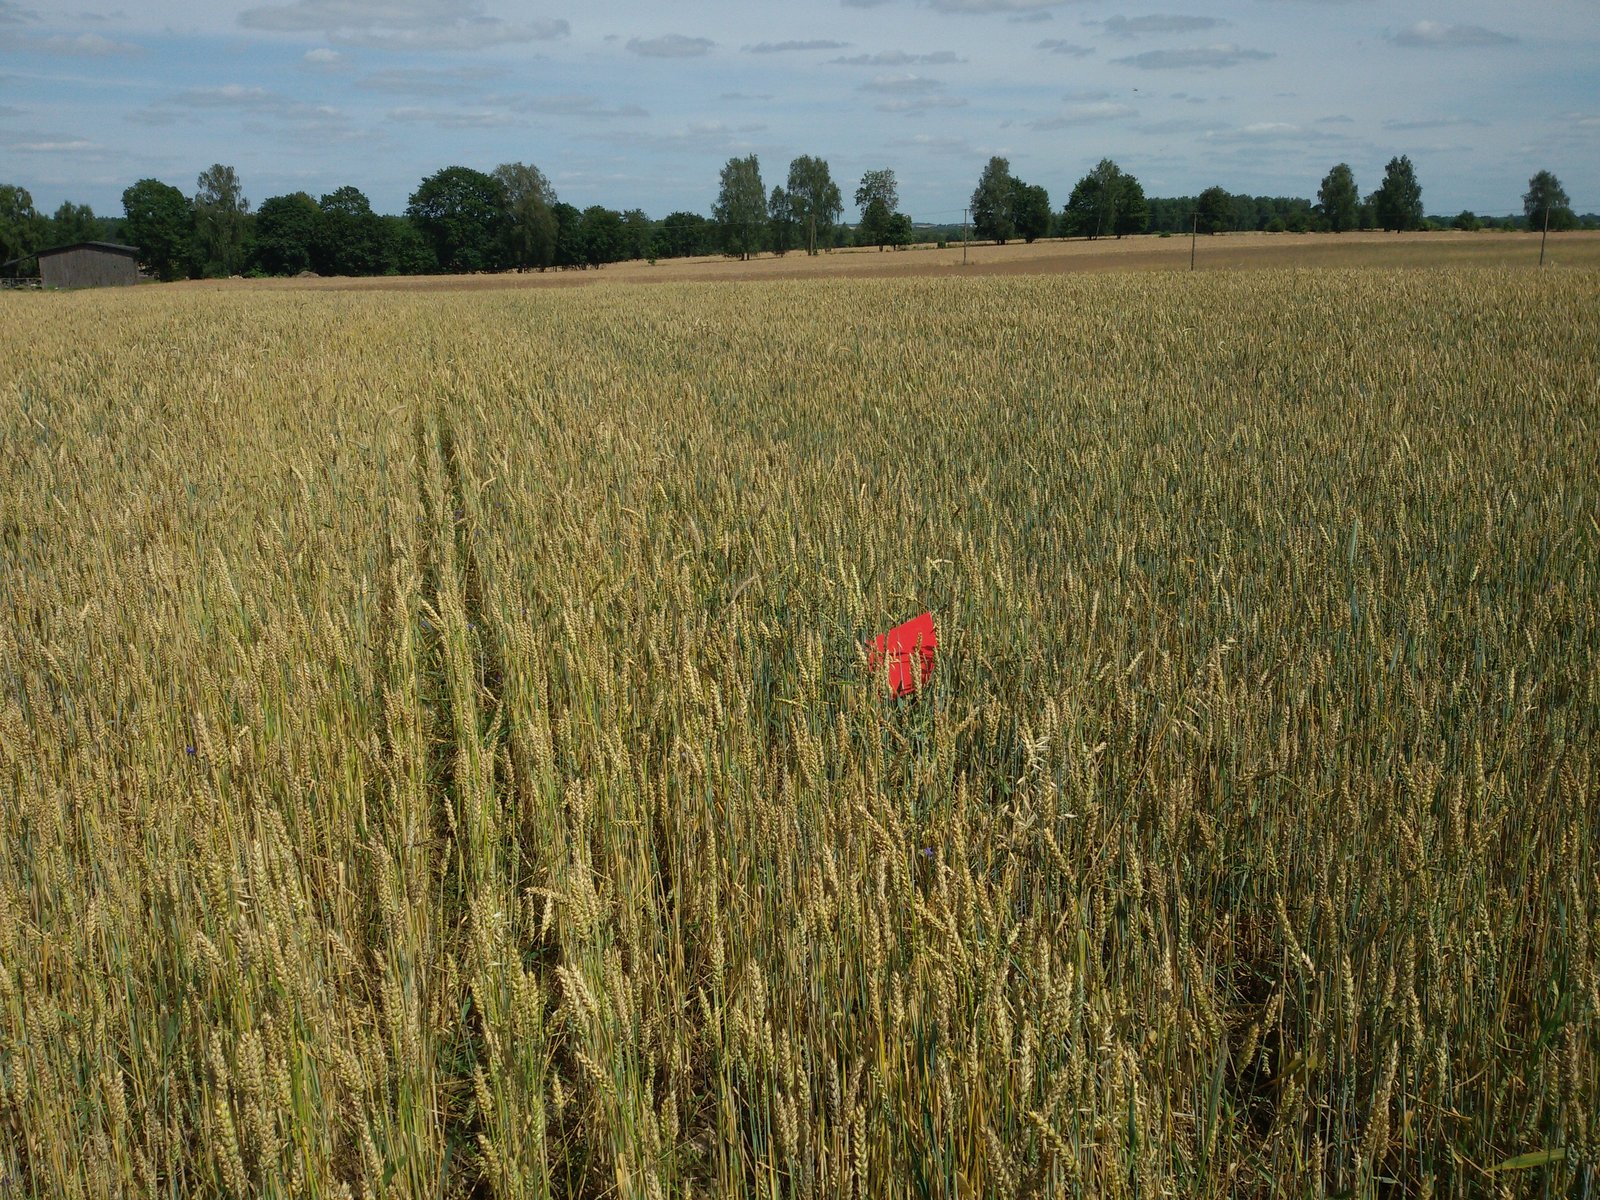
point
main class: Cropland
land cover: Common wheat
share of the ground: > 75 %
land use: Agriculture (excluding fallow land and kitchen gardens)
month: August
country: PL
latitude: 53.5533
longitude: 17.1191
